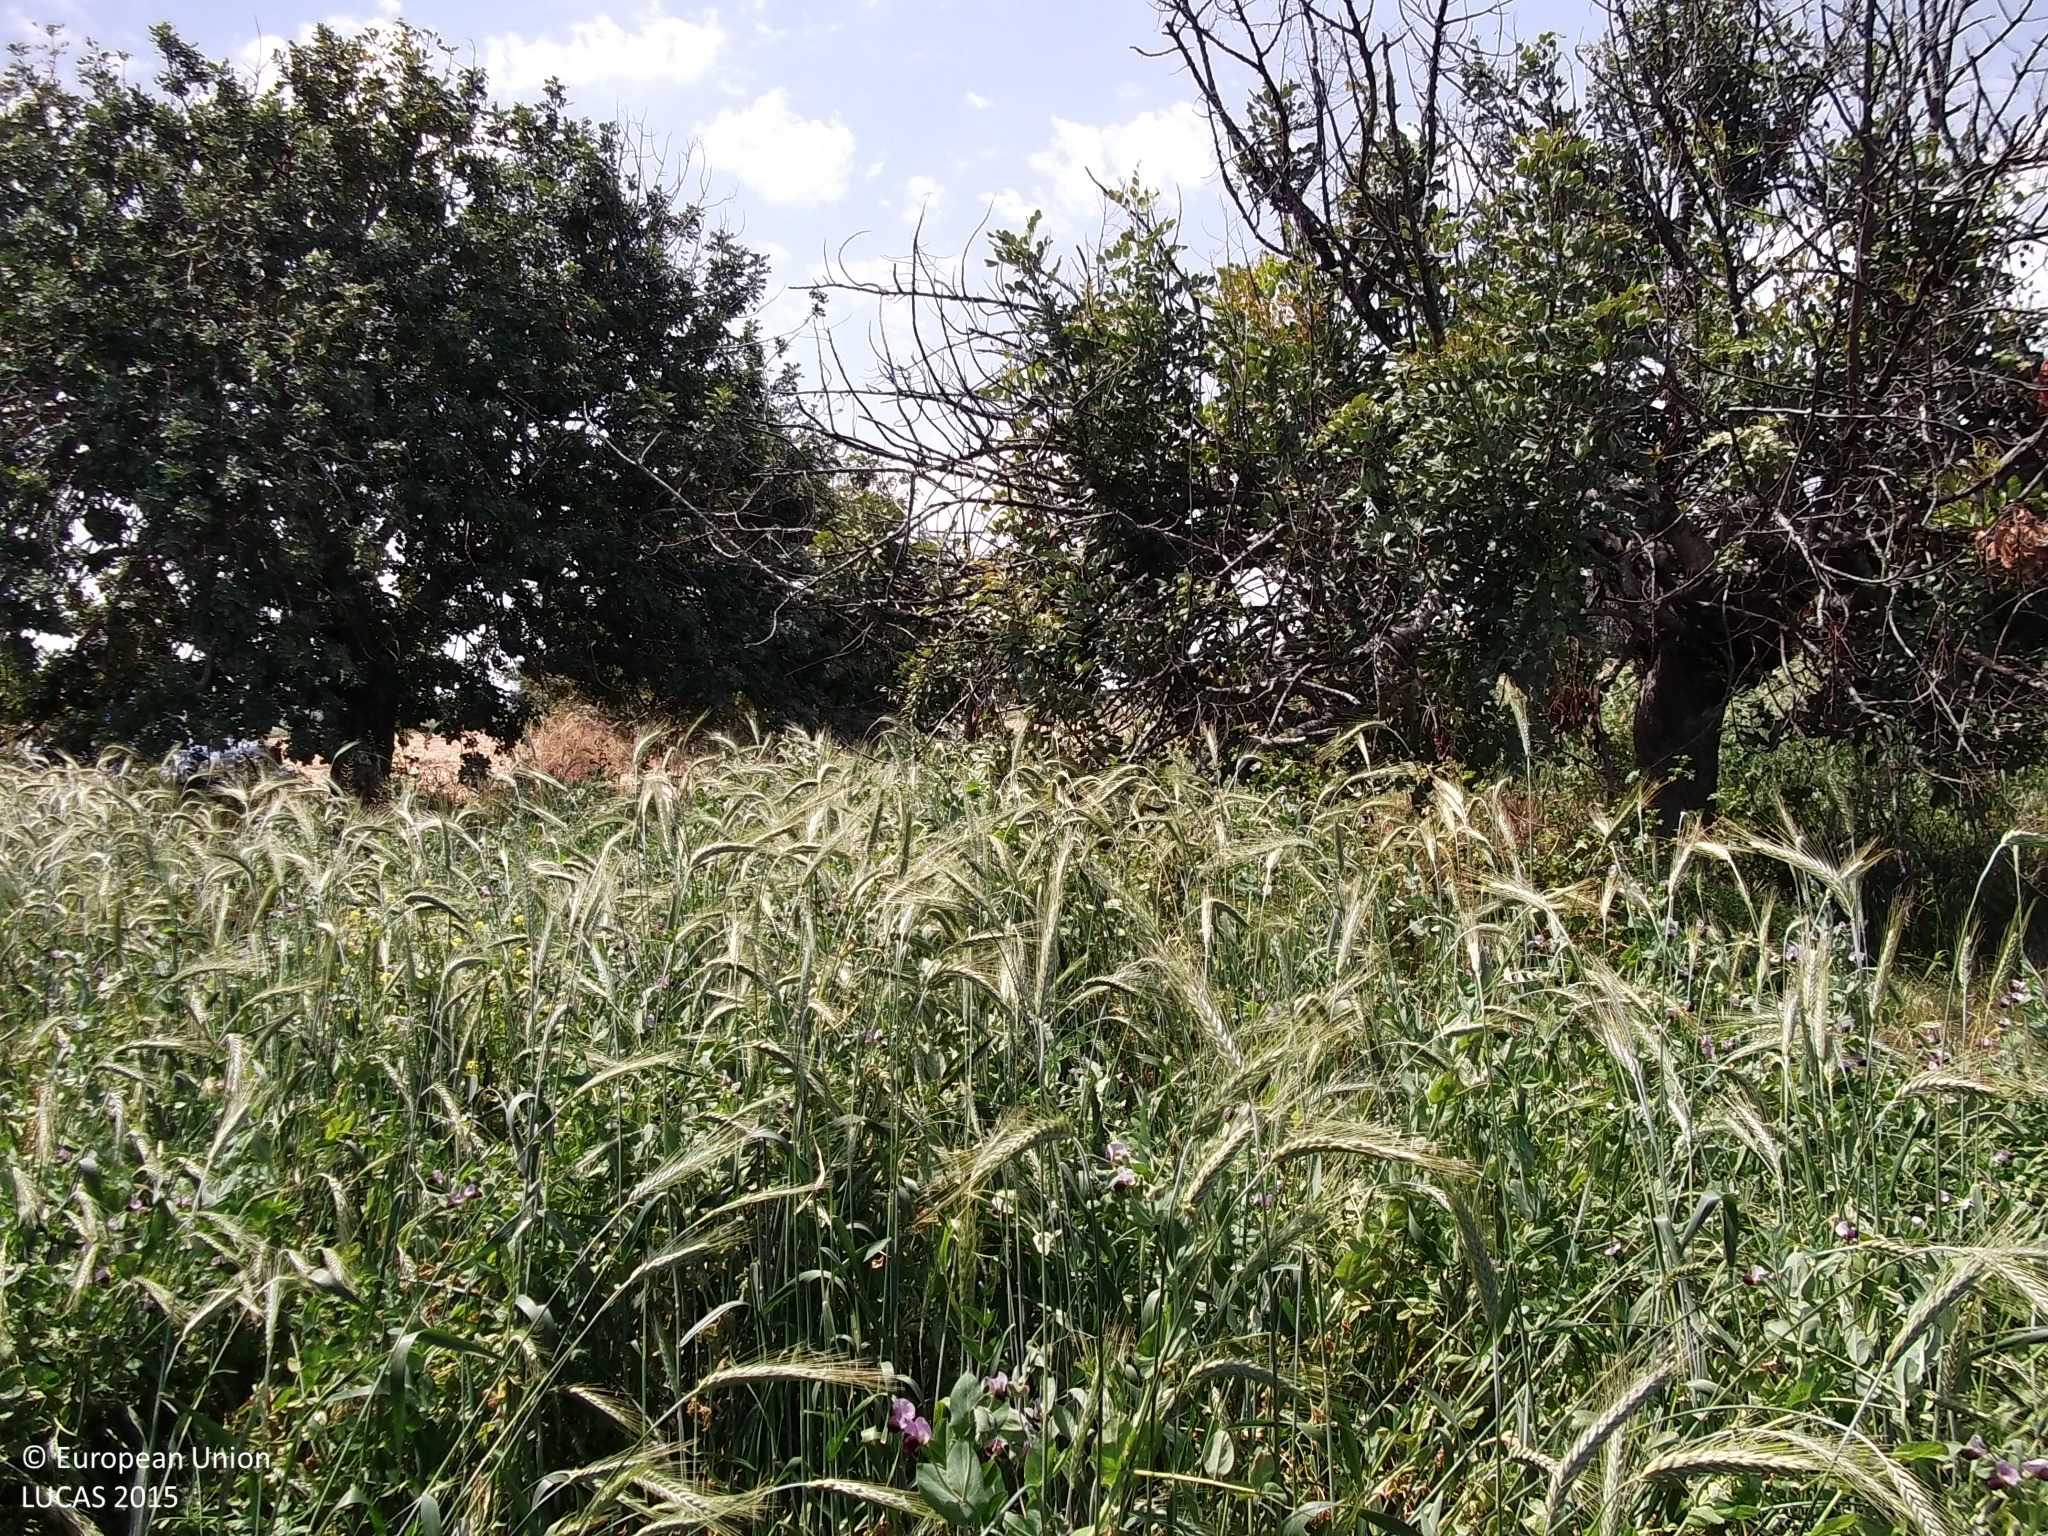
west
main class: Cropland
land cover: Permanent industrial crops
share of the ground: 25 - 50 %
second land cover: Common wheat
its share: > 75 %
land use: Agriculture (excluding fallow land and kitchen gardens)
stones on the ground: 25 - 50 %
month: April
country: CY
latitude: 34.8015
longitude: 33.4790
